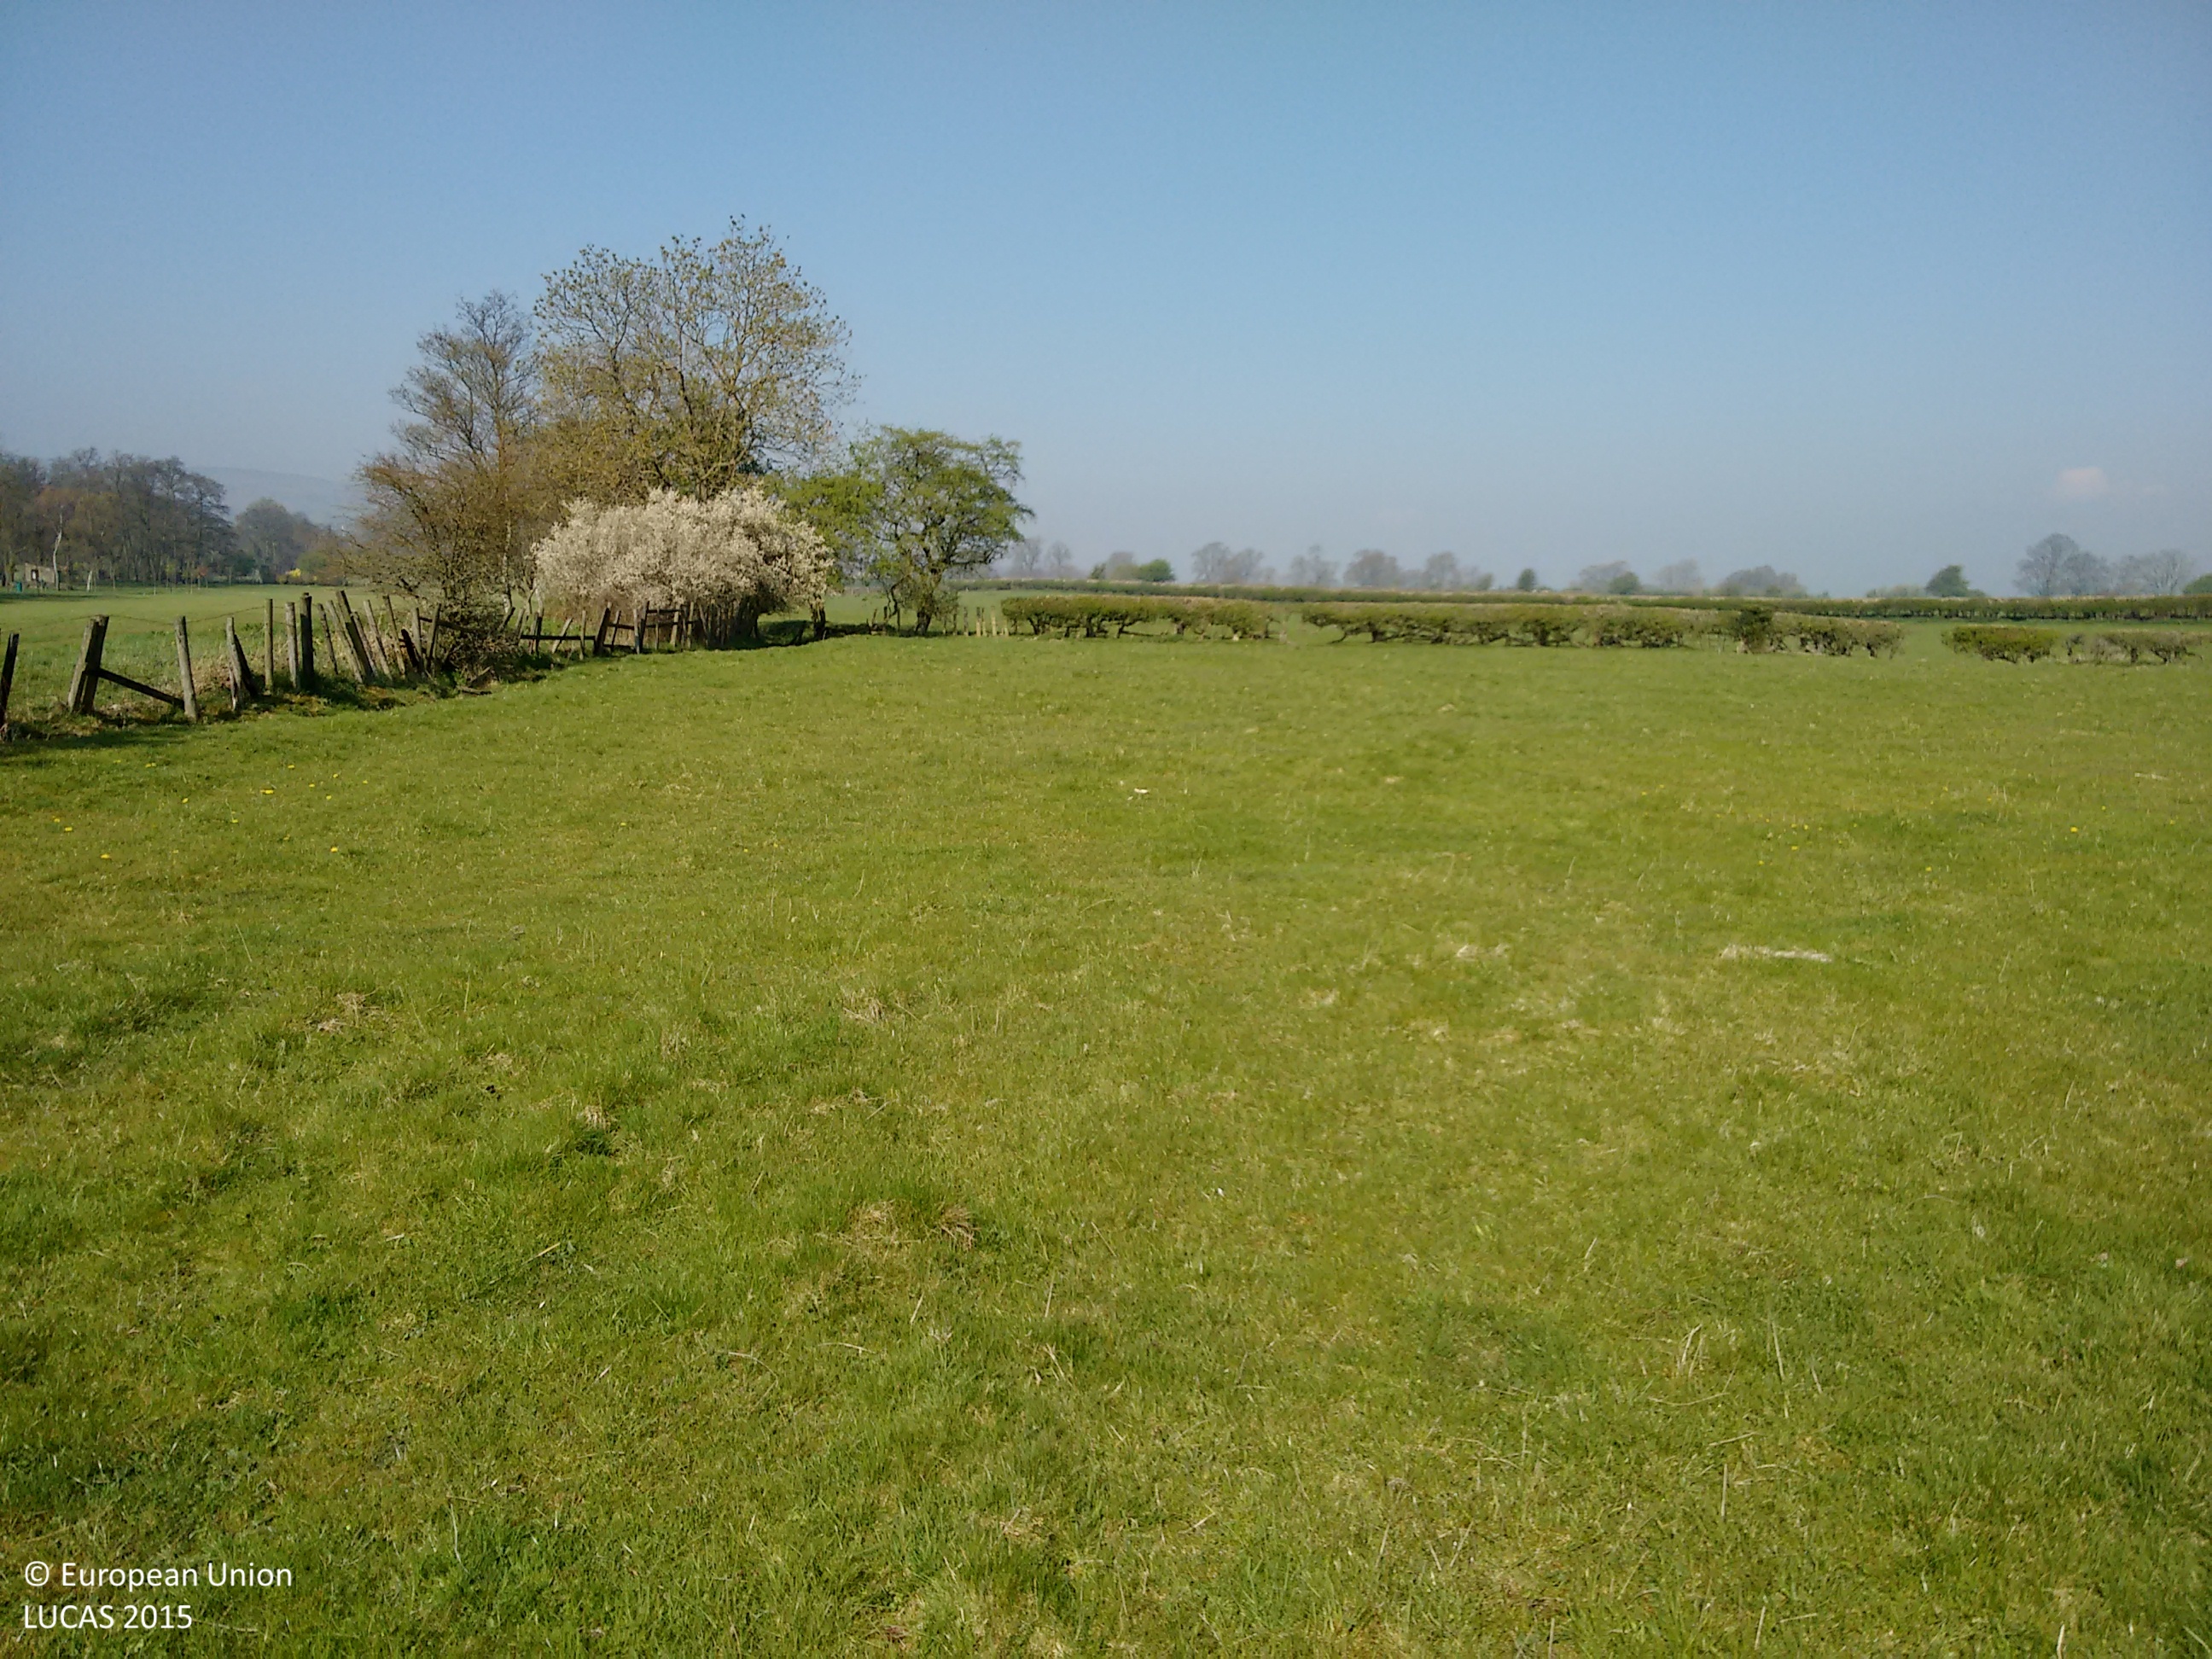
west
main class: Grassland
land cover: Grassland without tree/shrub cover
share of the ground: > 75 %
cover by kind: herbaceous plants 100 %
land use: Agriculture (excluding fallow land and kitchen gardens)
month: April
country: GB
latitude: 53.9023
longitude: -1.7265
